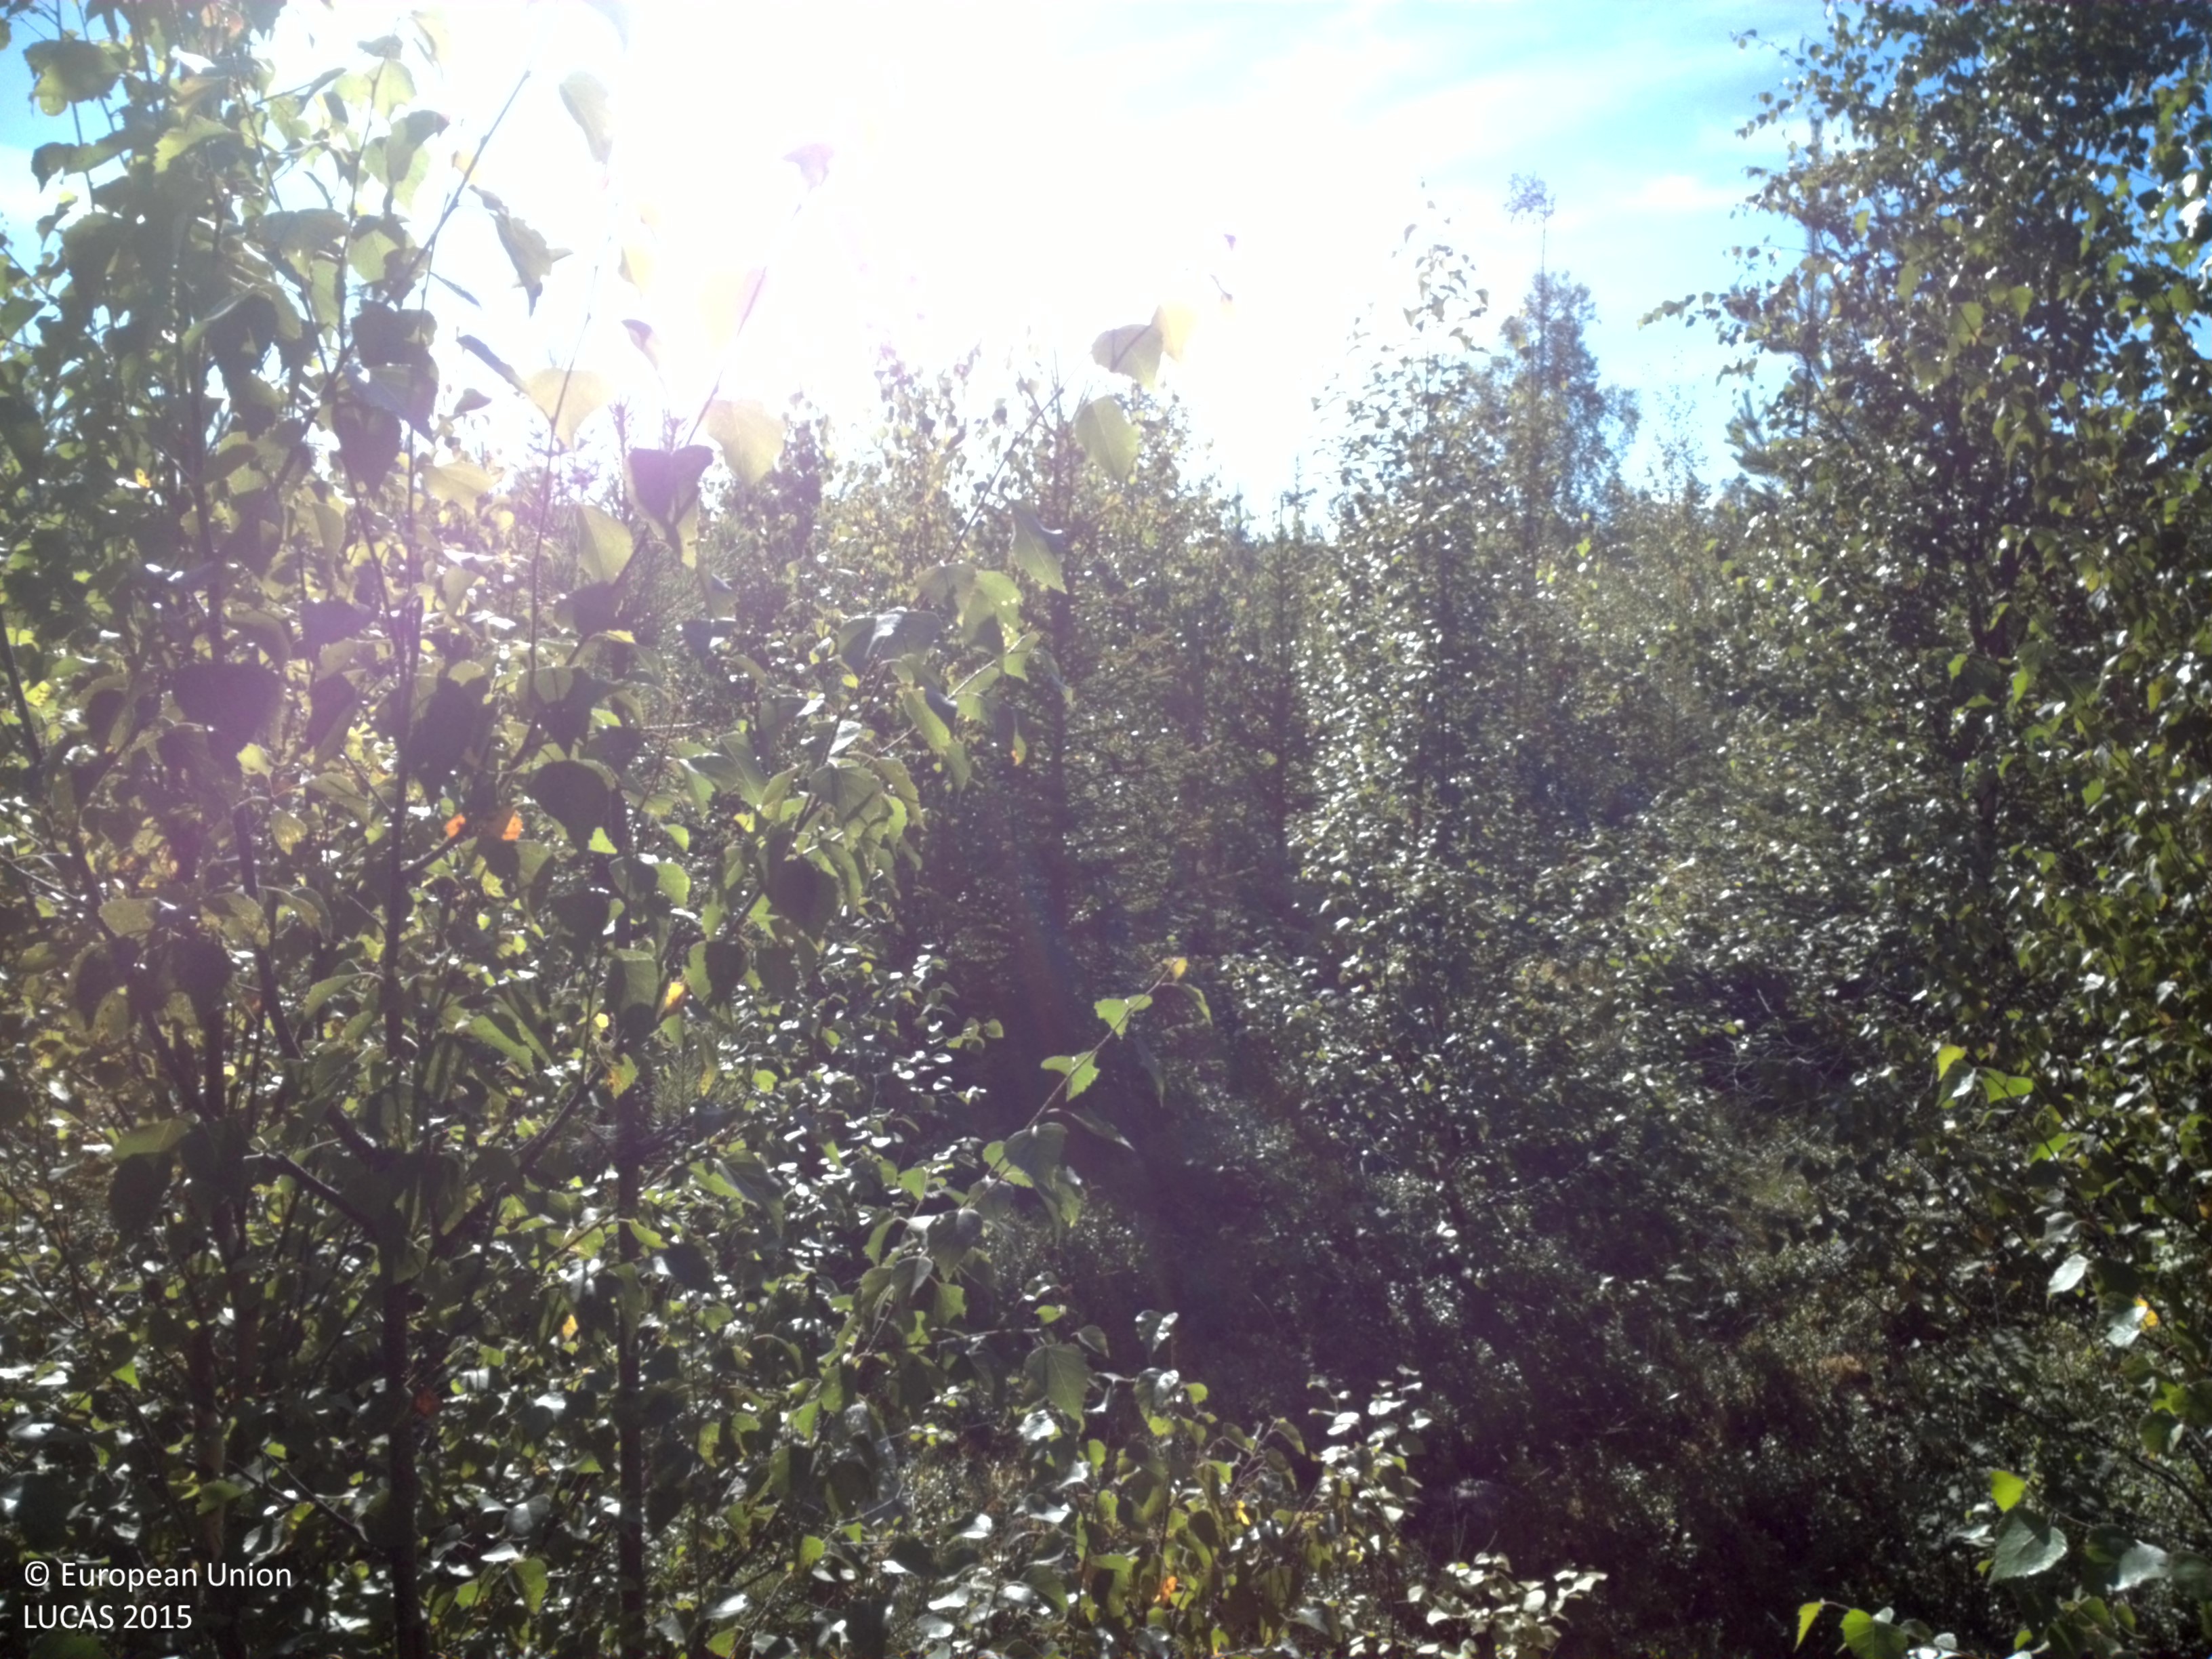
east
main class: Woodland
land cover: Broadleaved woodland
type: boreal forest
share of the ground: > 75 %
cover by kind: broadleaved forest trees 75 %, coniferous forest trees 10 %, shrubs 10 %, herbaceous plants 5 %
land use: Forestry
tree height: < 5 m
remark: Clear cut
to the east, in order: Broadleaved woodland; Pine dominated mixed woodland; Other mixed woodland; Pine dominated mixed woodland
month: August
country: SE
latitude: 64.5005
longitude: 20.5745
